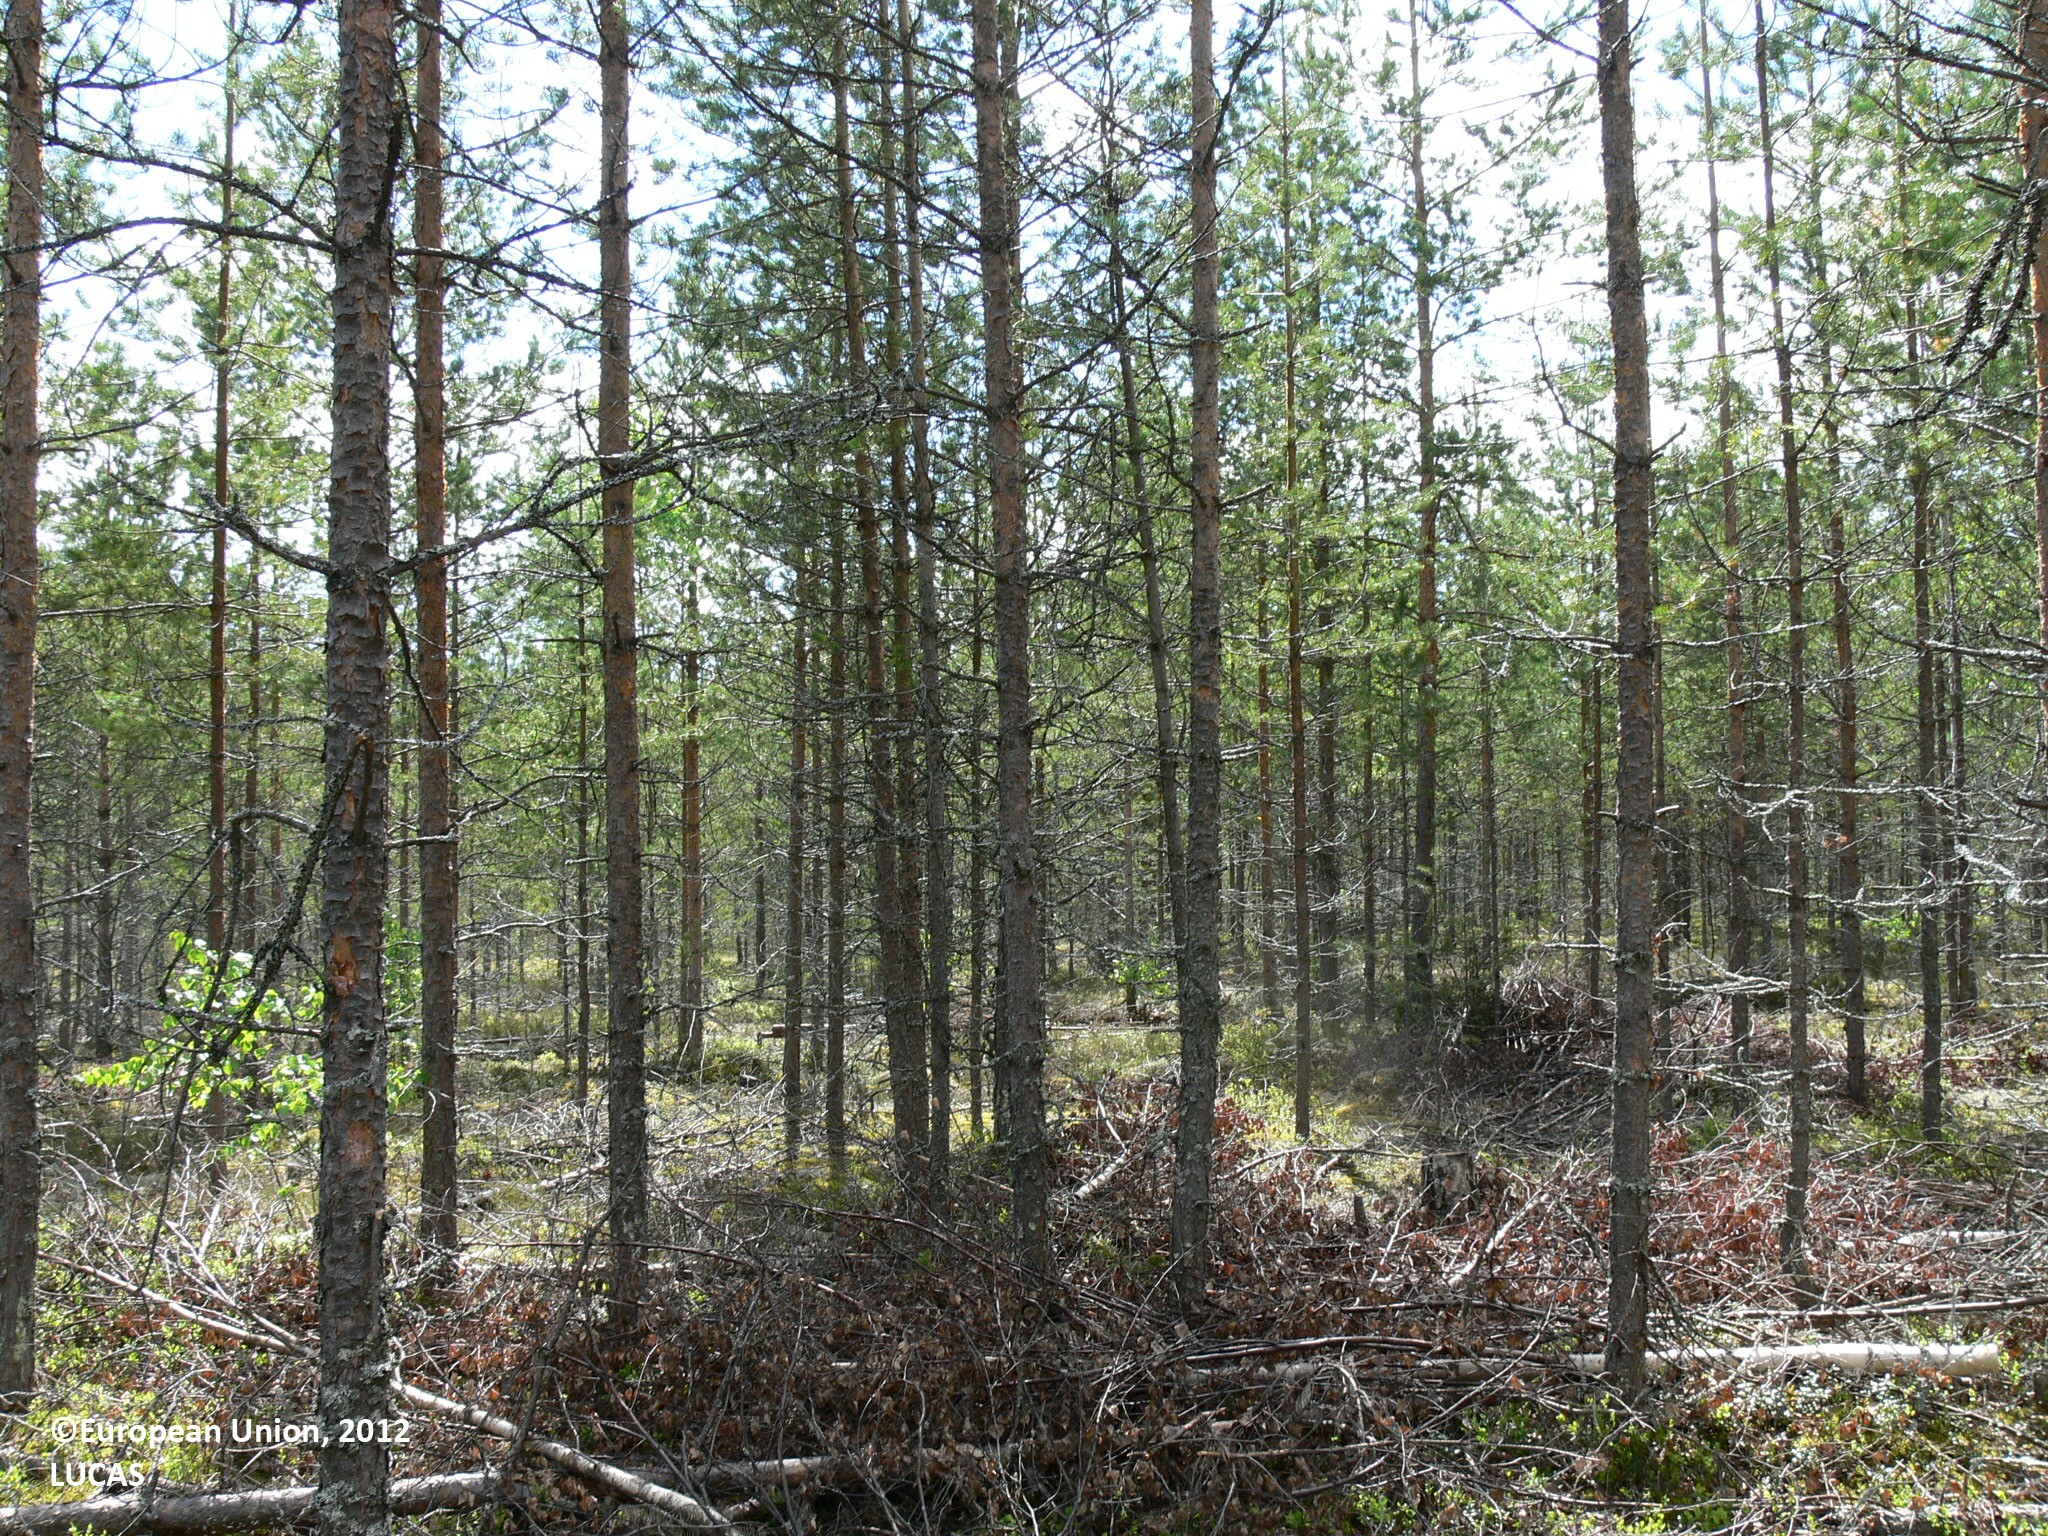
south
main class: Woodland
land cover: Pine dominated mixed woodland
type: boreal forest
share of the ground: > 75 %
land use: Forestry
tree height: < 5 m
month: June
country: FI
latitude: 62.6834
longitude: 29.7611
